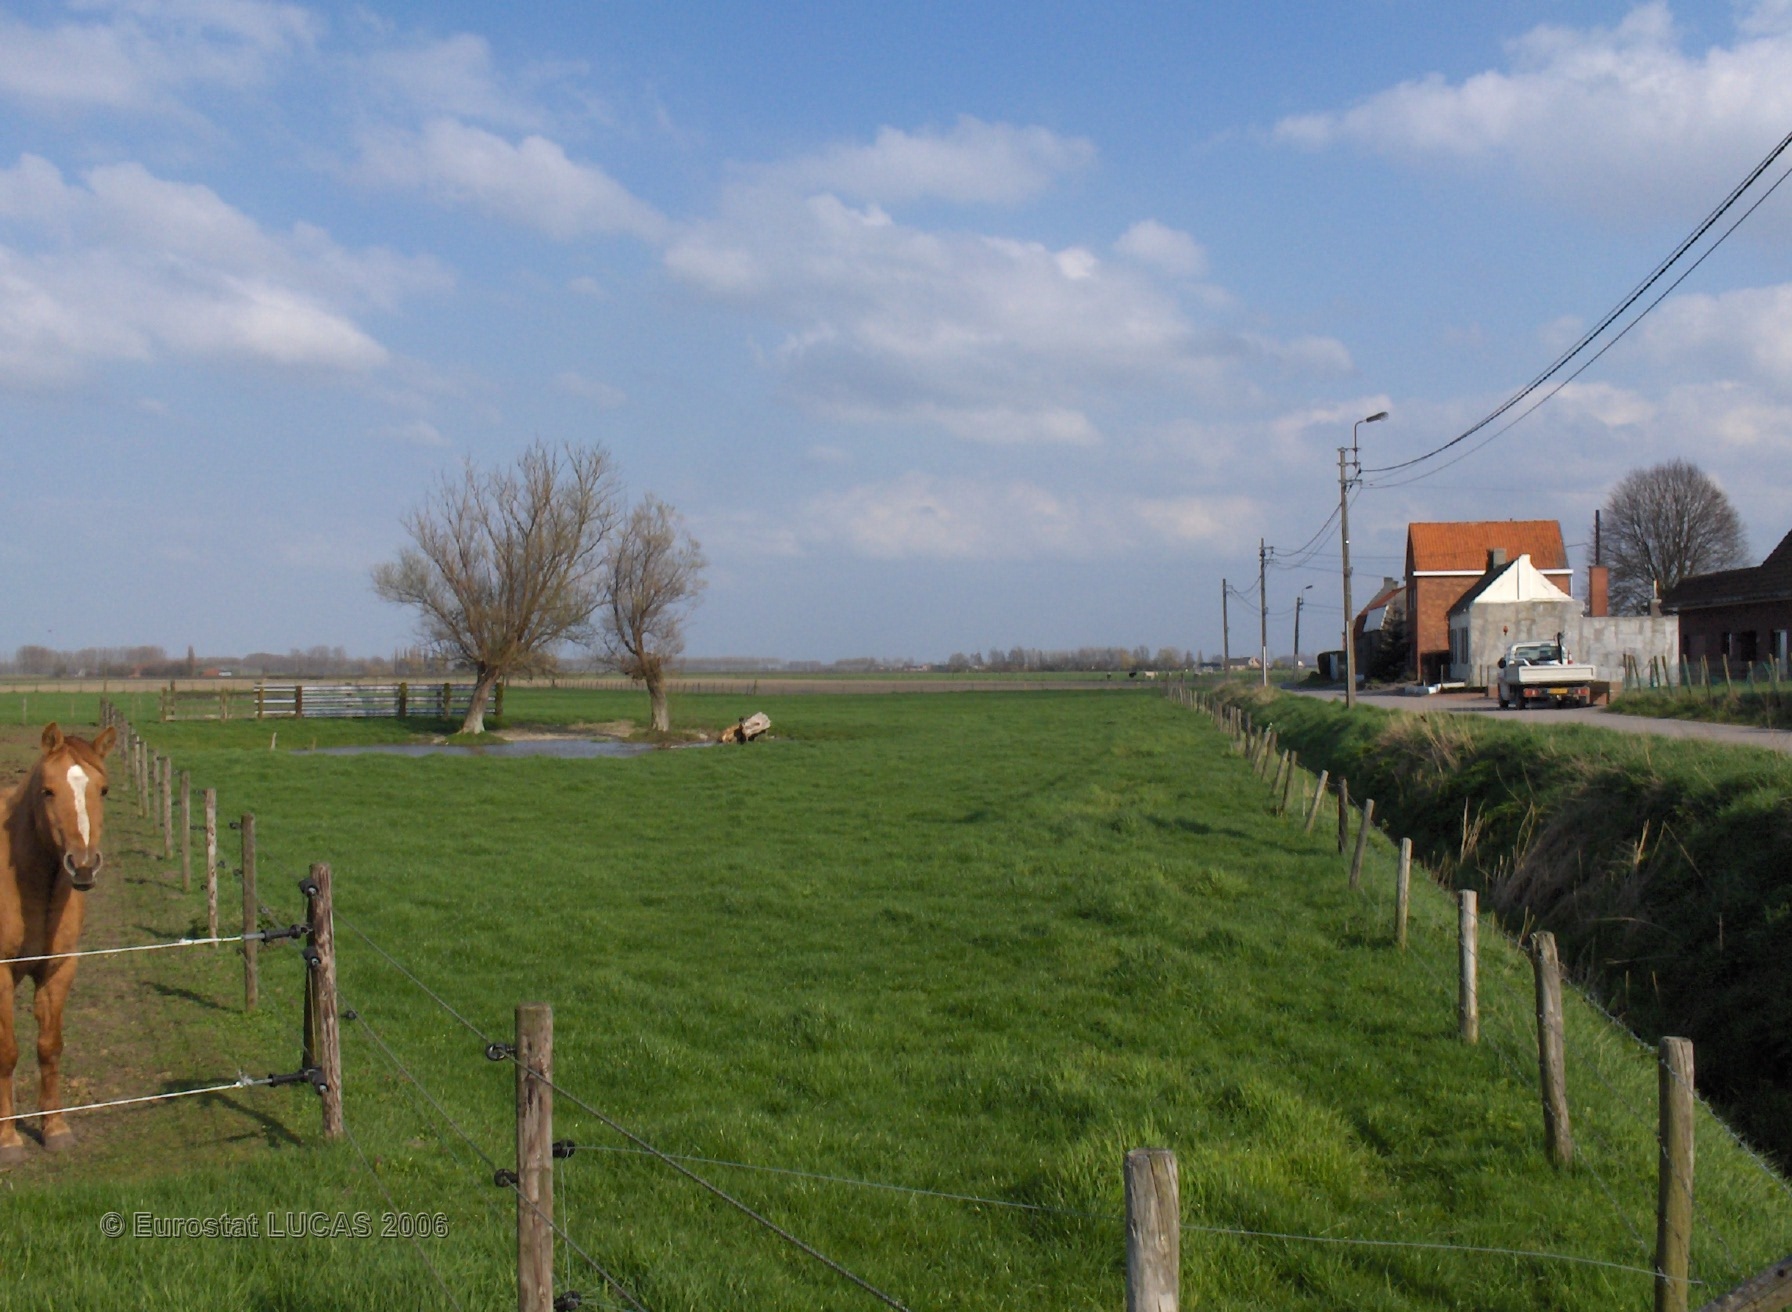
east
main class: Grassland
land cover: Grassland without tree/shrub cover
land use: Agriculture (excluding fallow land and kitchen gardens)
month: April
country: BE
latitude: 51.2873
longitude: 3.6407
